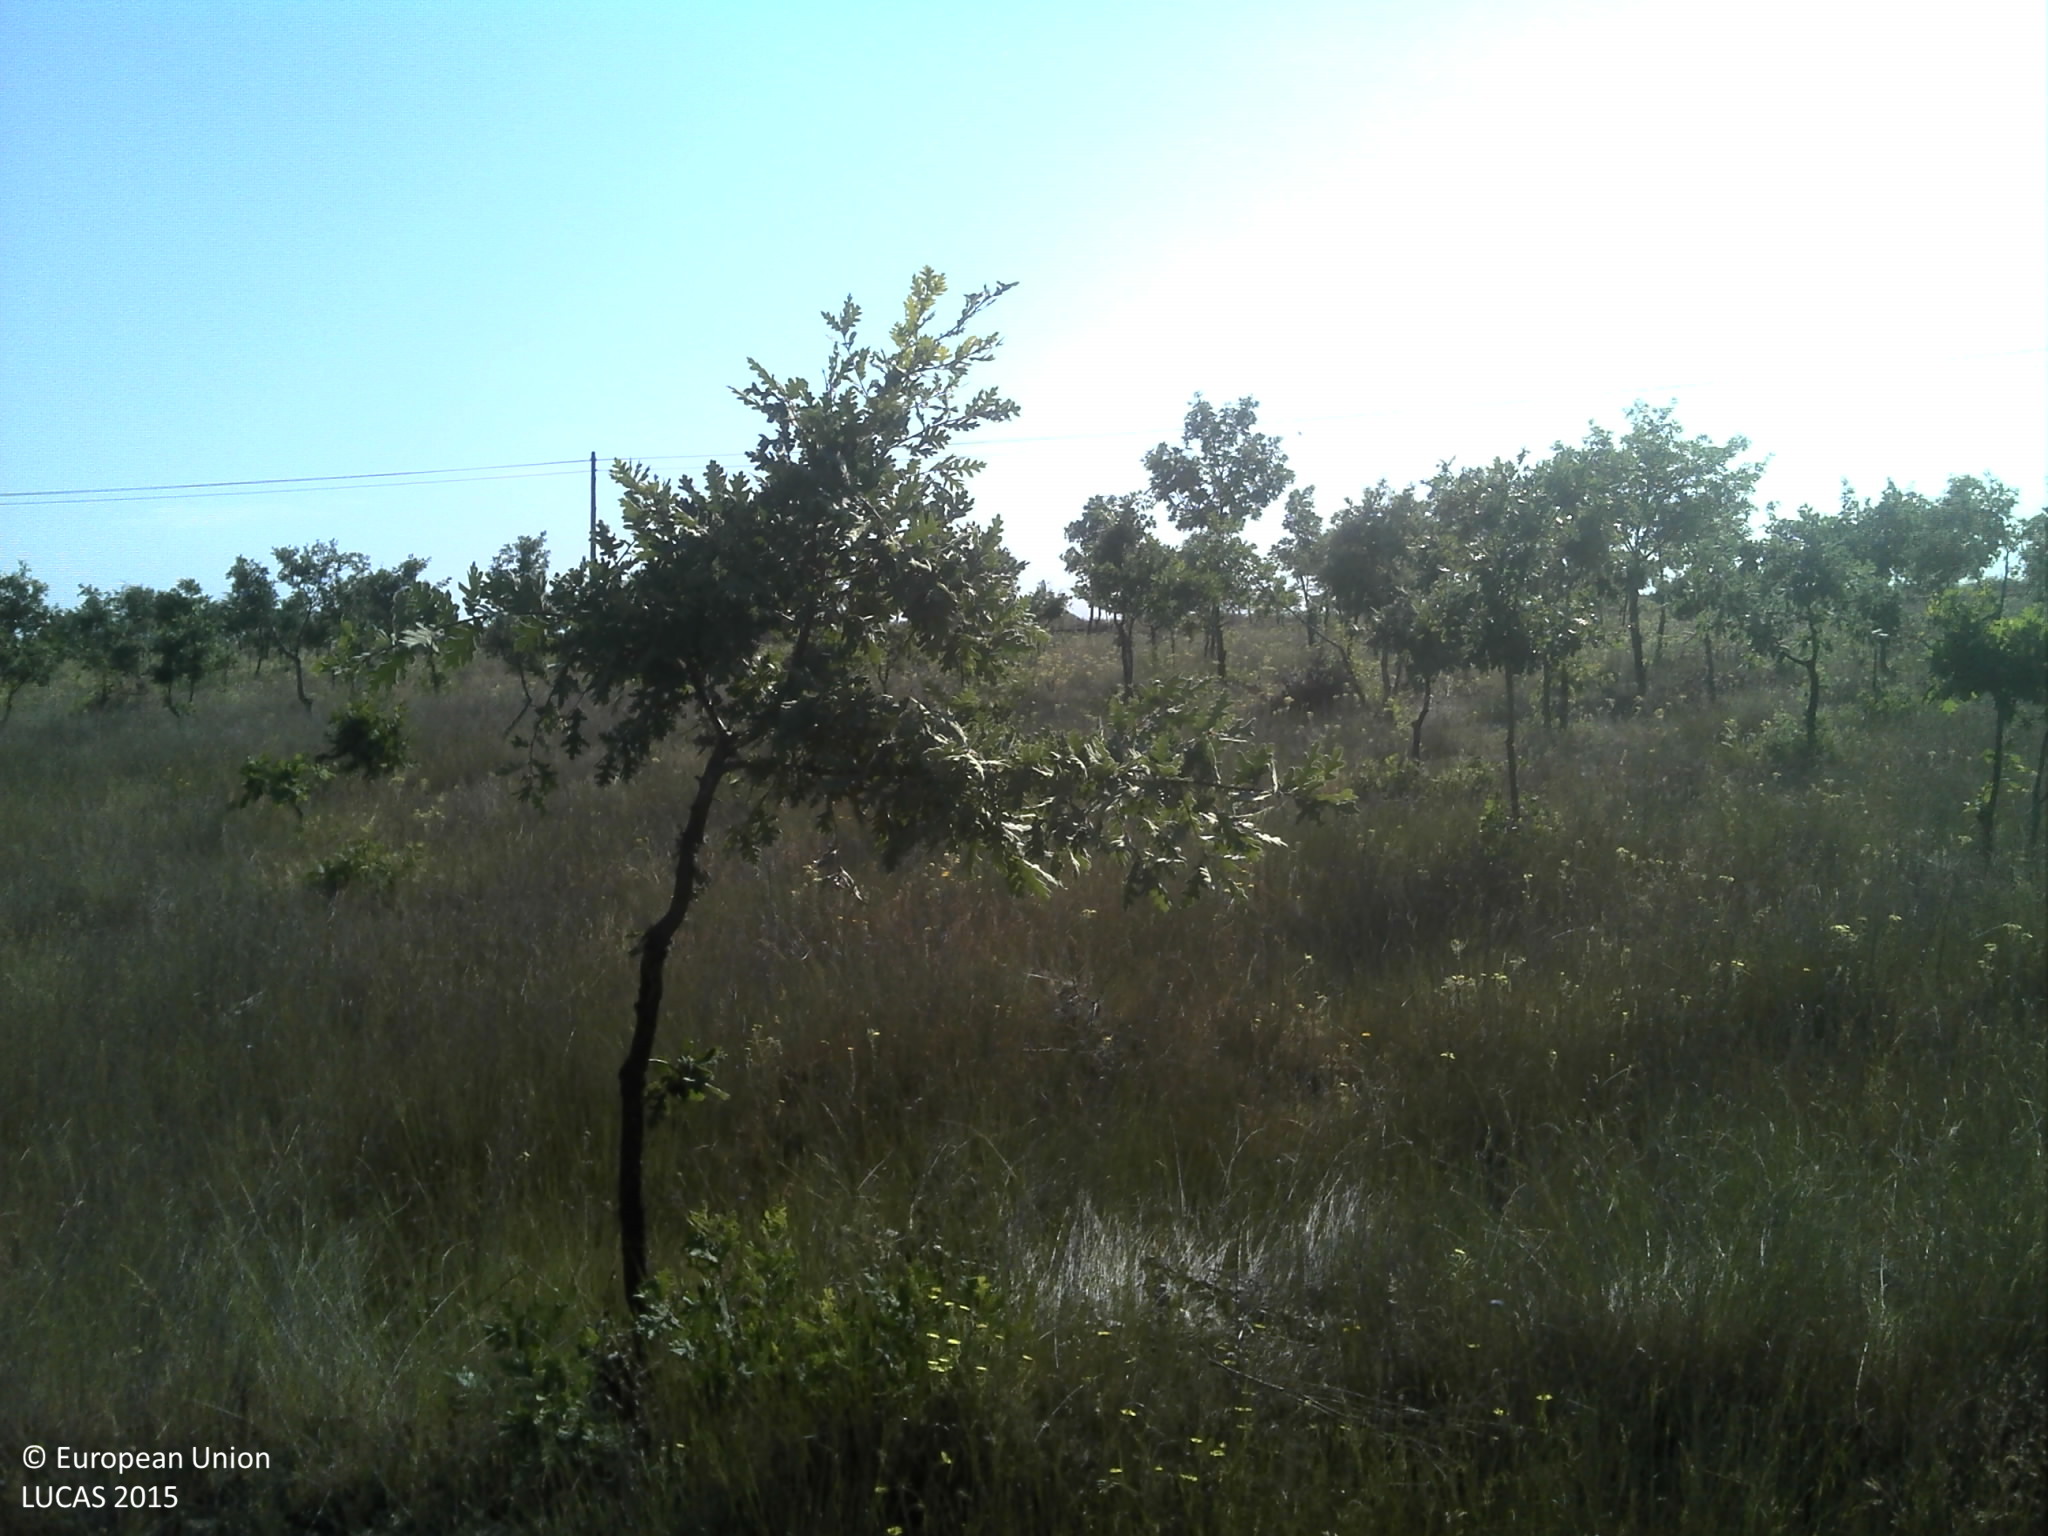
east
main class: Woodland
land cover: Broadleaved woodland
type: acidophilous oak and oak-birch forest
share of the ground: 10 - 25 %
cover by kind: herbaceous plants 60 %, broadleaved forest trees 25 %, unconsolidated bare surface 15 %
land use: Forestry
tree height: < 5 m
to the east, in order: Broadleaved woodland; Electric lines; Broadleaved woodland; Fences; Grass margins; Paved roads, cycling and walking lanes; Grass margins; Grassland without tree/shrub cover; Ditches and canals; Tracks; Grass margins; Fences; Oats; Fences; Grass margins; Tracks; Grass margins; Fences; Single bushes/trees; Rye
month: June
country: PT
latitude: 40.5878
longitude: -6.8386
